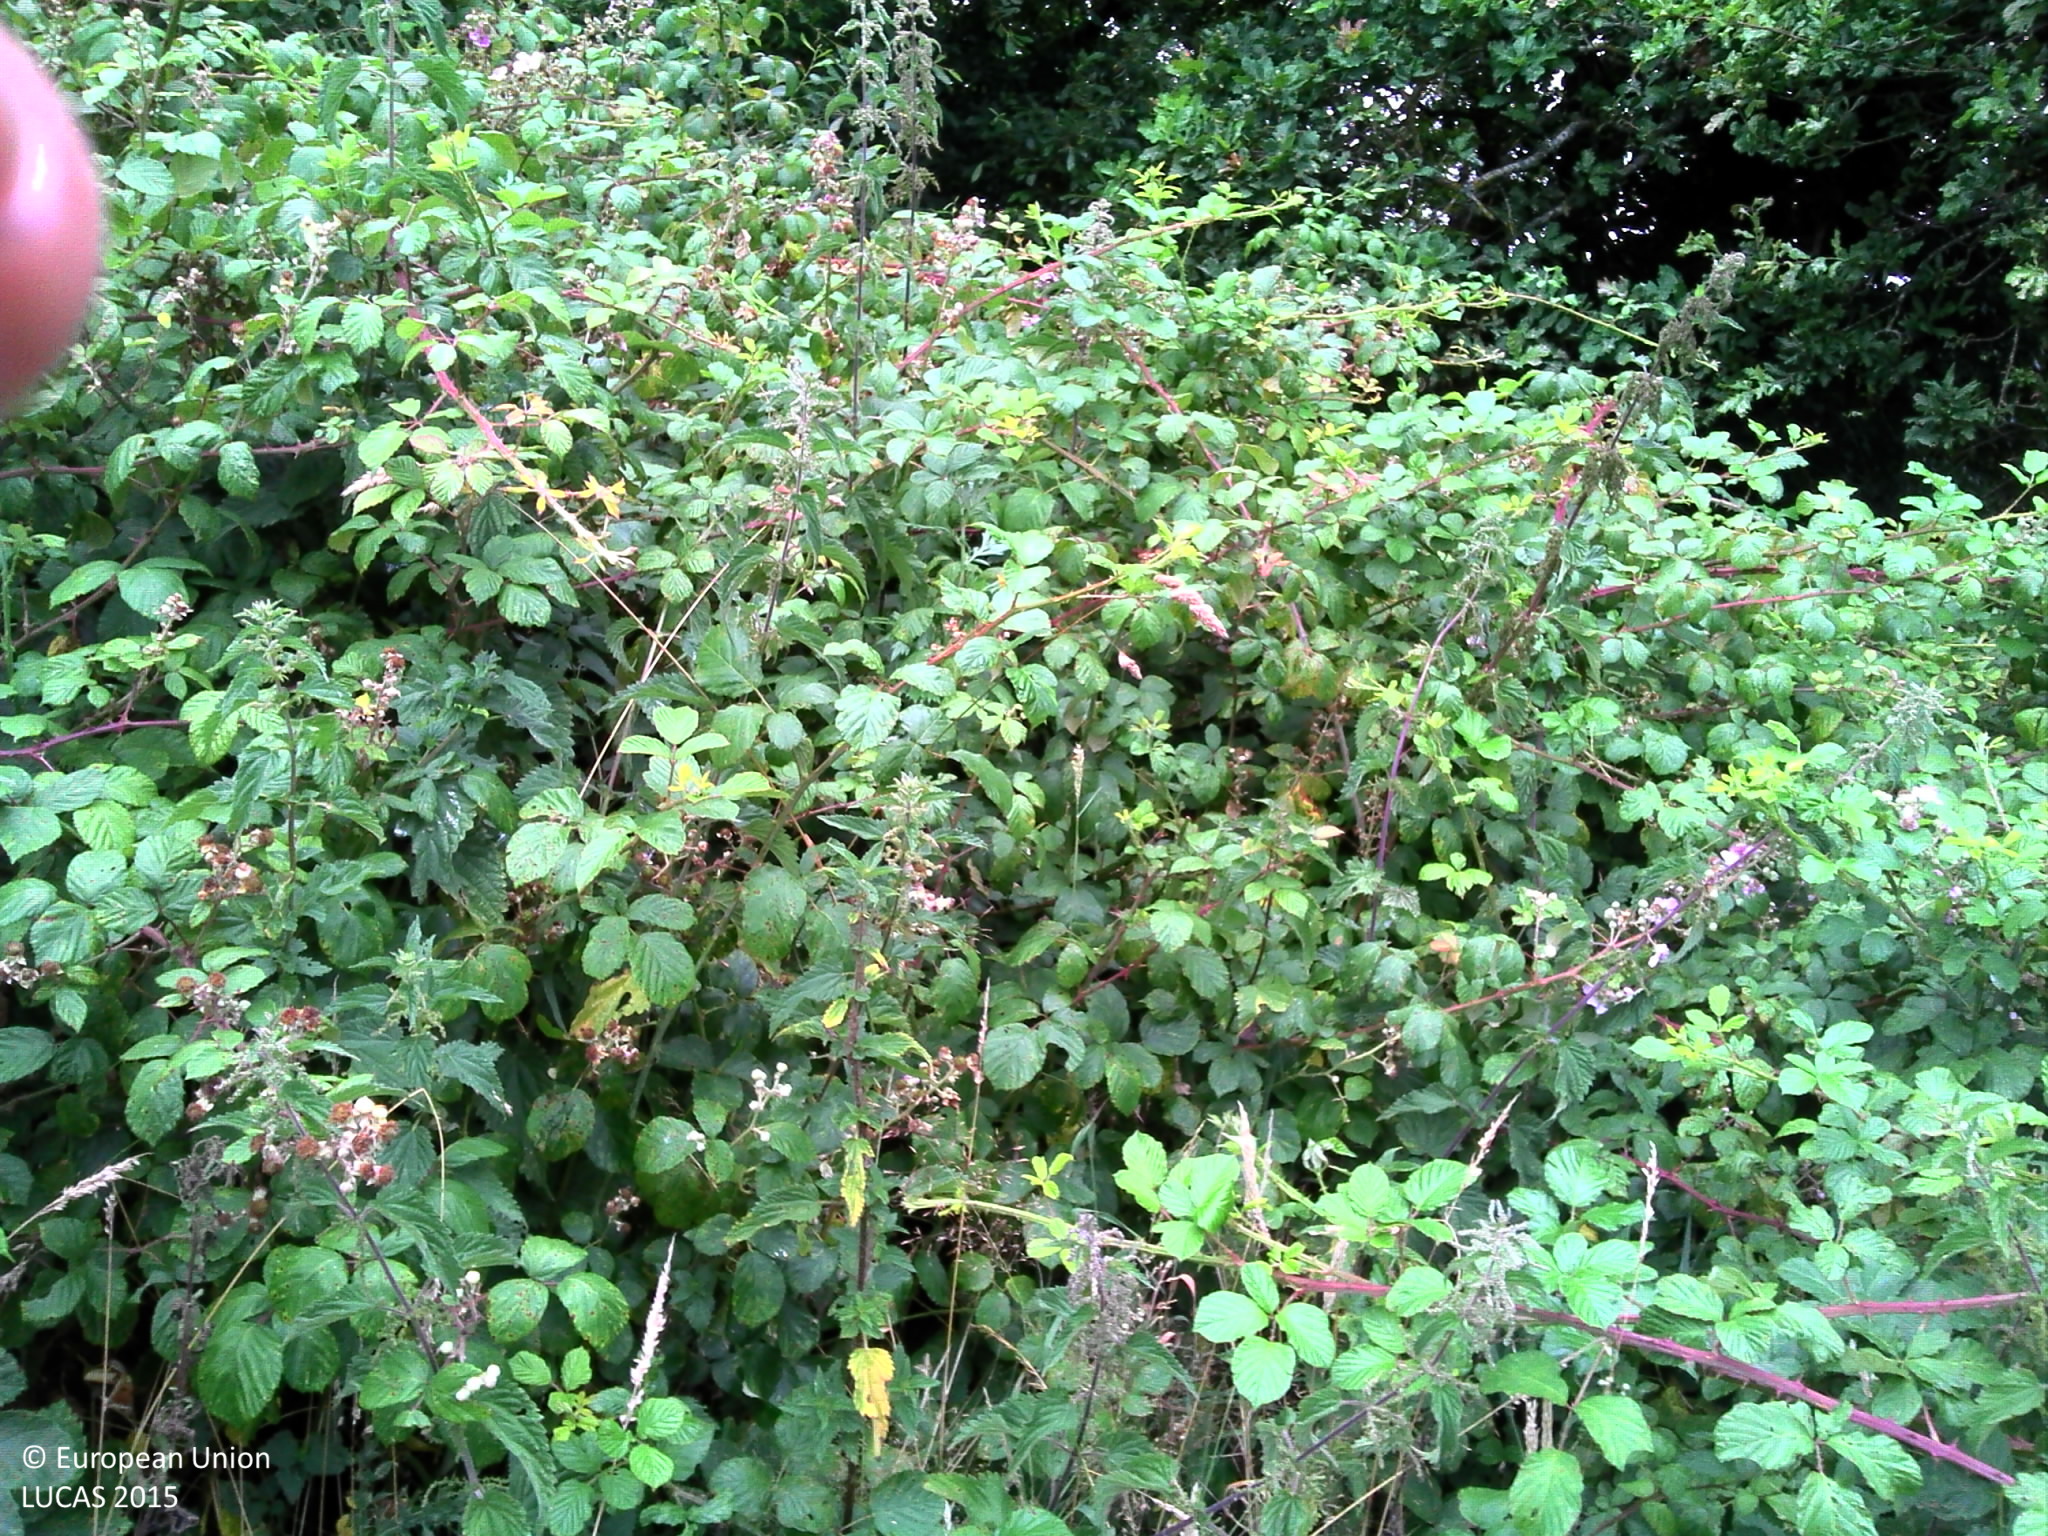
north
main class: Woodland
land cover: Broadleaved woodland
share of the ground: > 75 %
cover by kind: broadleaved forest trees 50 %, shrubs 30 %, herbaceous plants 10 %, consolidated bare surface 10 %
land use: Forestry
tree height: < 5 m
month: July
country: FR
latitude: 47.7141
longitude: -3.2262
